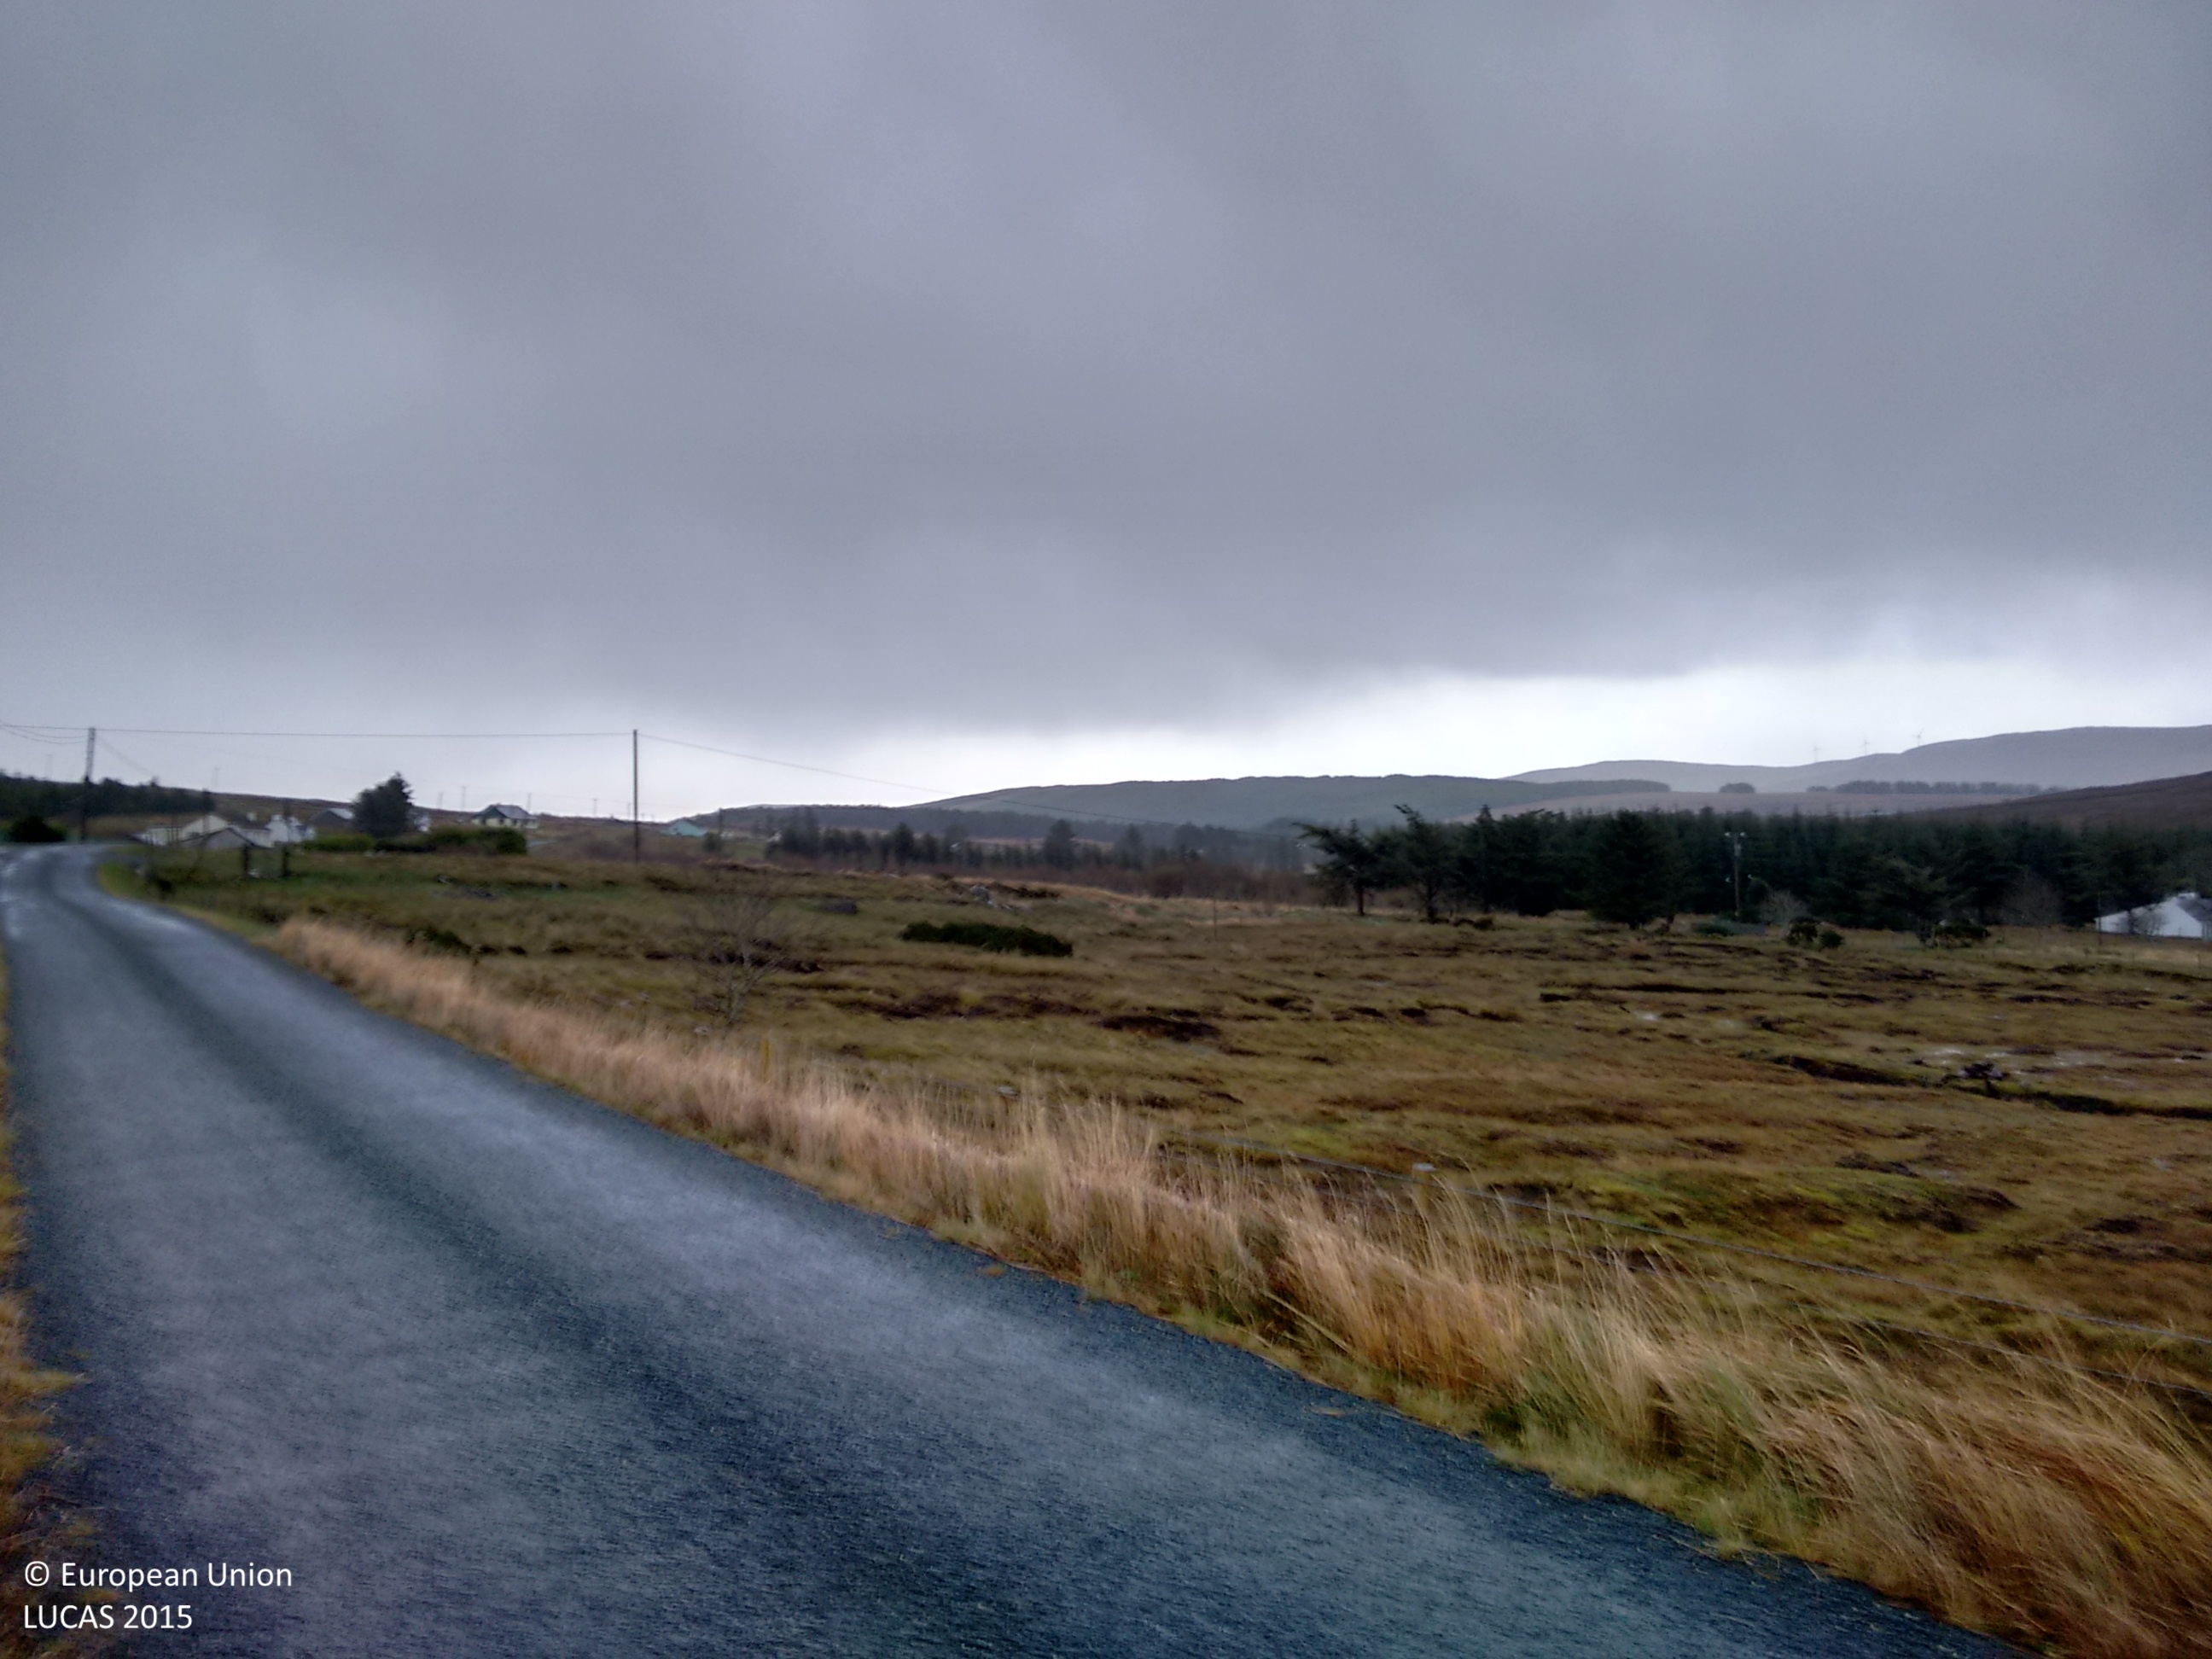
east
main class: Grassland
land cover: Grassland without tree/shrub cover
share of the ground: > 75 %
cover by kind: herbaceous plants 100 %
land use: Agriculture (excluding fallow land and kitchen gardens)
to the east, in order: Grassland without tree/shrub cover; Rivers and streams; Grassland without tree/shrub cover; Electric lines; Grassland without tree/shrub cover; Fences; Ditches and canals; Grass margins; Paved roads, cycling and walking lanes; Grass margins; Fences; Grassland without tree/shrub cover; Ditches and canals; Grassland without tree/shrub cover; Ditches and canals; Grassland without tree/shrub cover; Electric lines; Grassland without tree/shrub cover; Fences; Grassland without tree/shrub cover; Tracks; Shrubland with sparse tree cover; Rivers and streams; Grassland with sparse tree/shrub cover
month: November
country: IE
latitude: 54.7174
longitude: -8.5898
